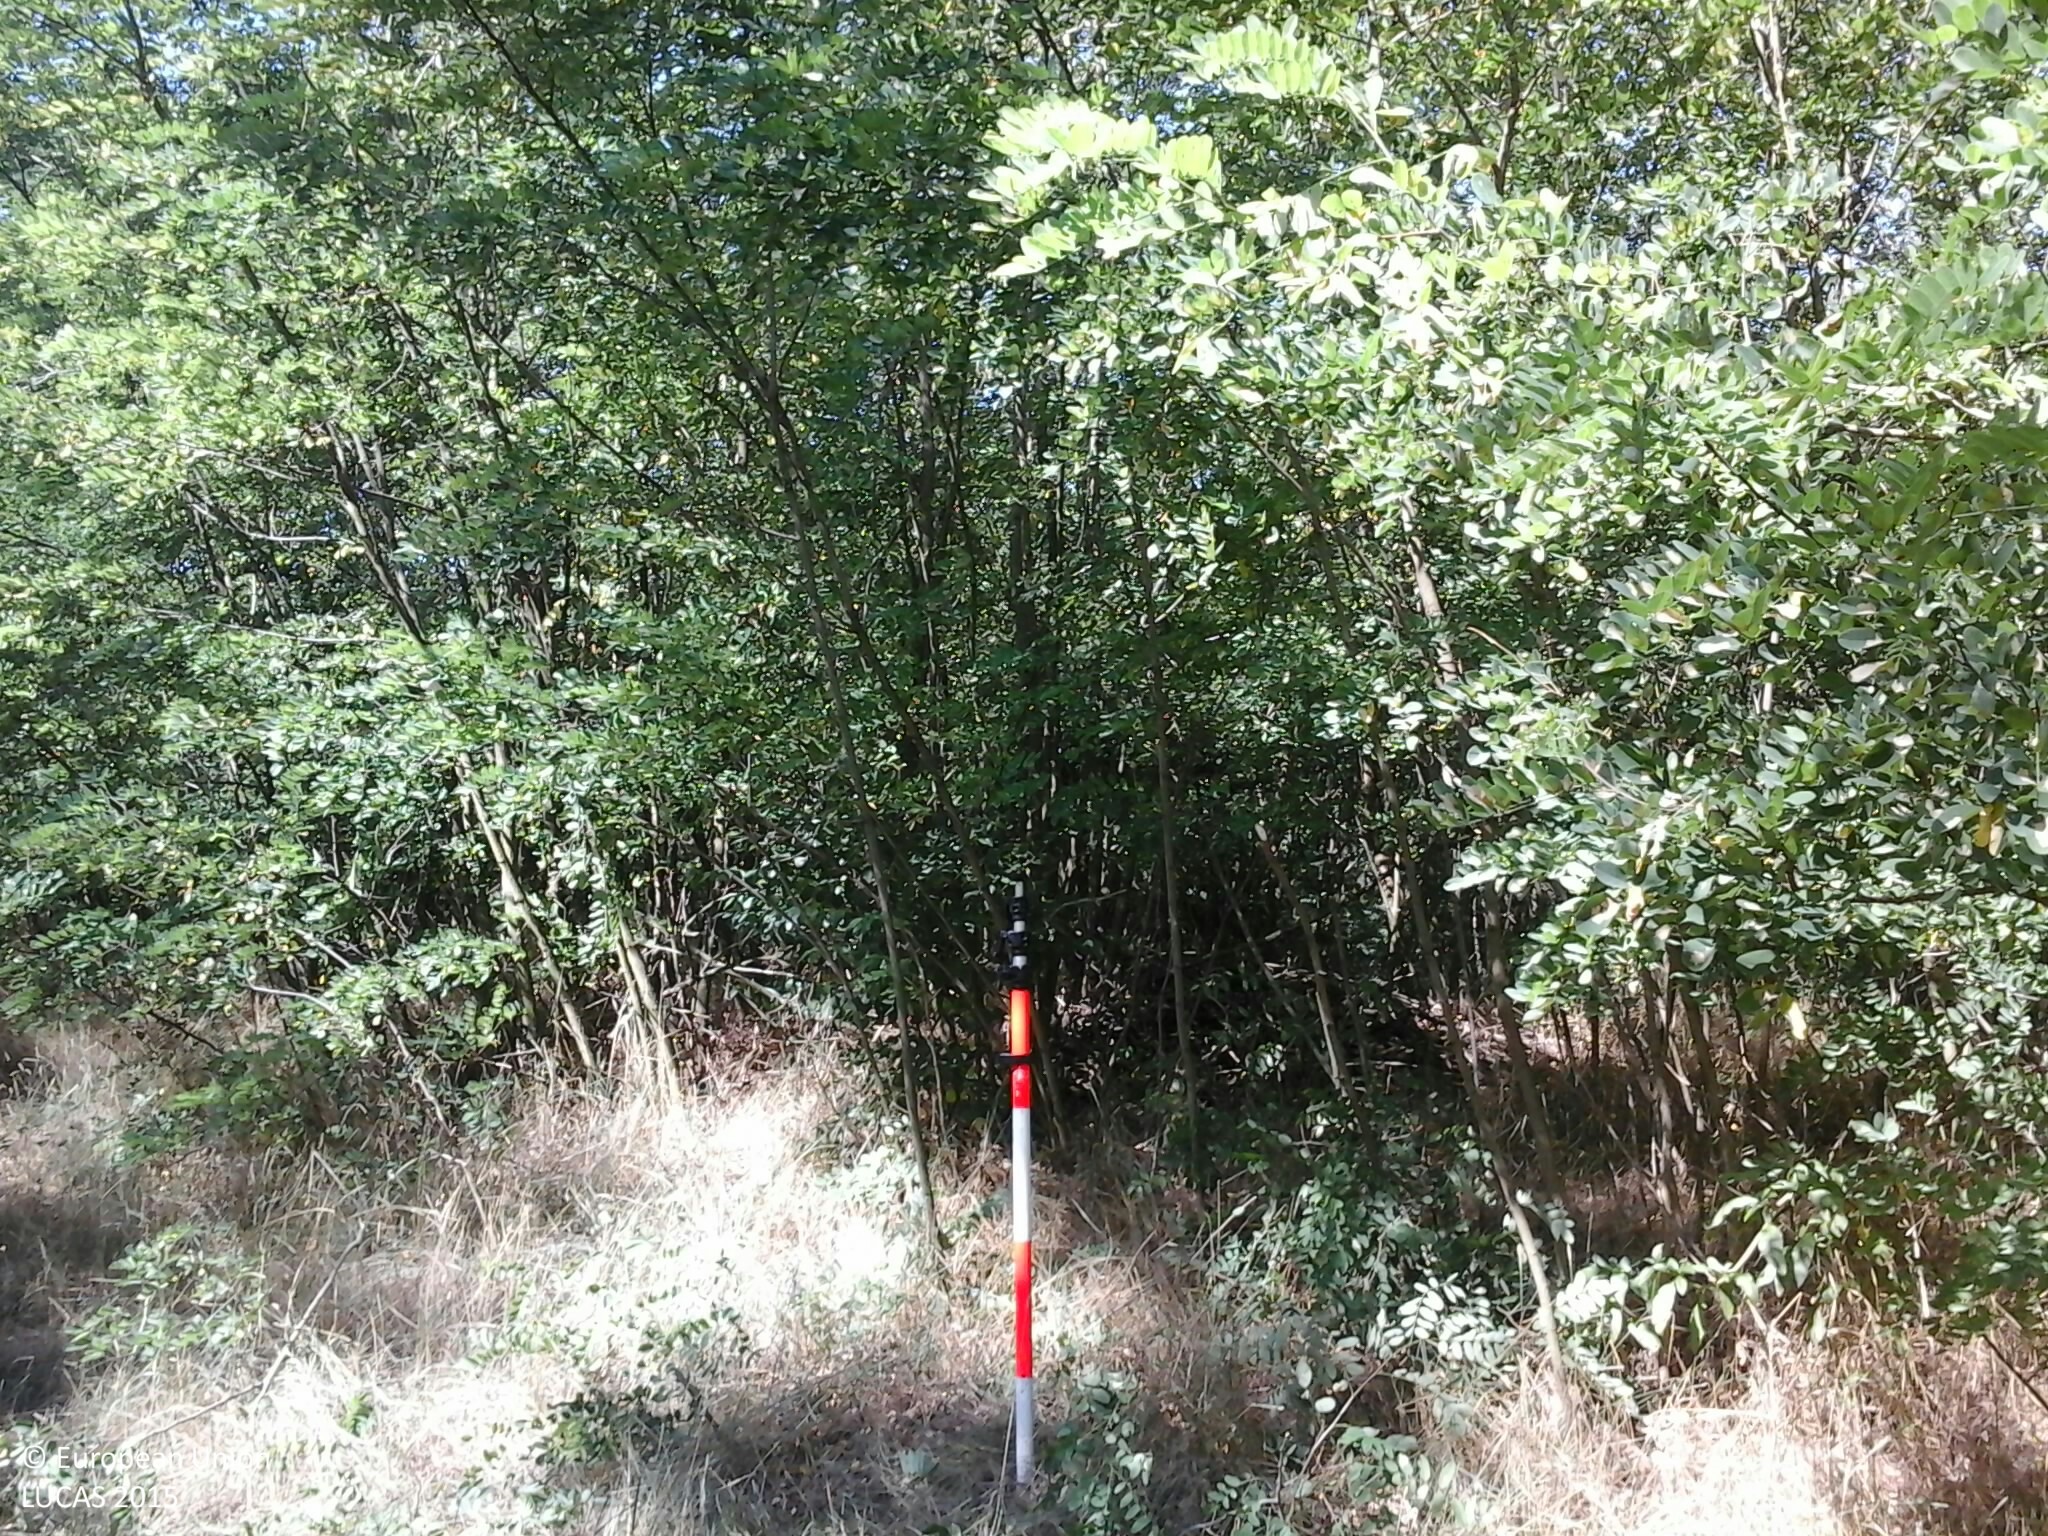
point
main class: Woodland
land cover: Broadleaved woodland
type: exotic forest
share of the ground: > 75 %
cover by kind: broadleaved forest trees 95 %, herbaceous plants 5 %
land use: Forestry
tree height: > 5 m
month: July
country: HU
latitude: 47.6365
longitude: 22.1779
